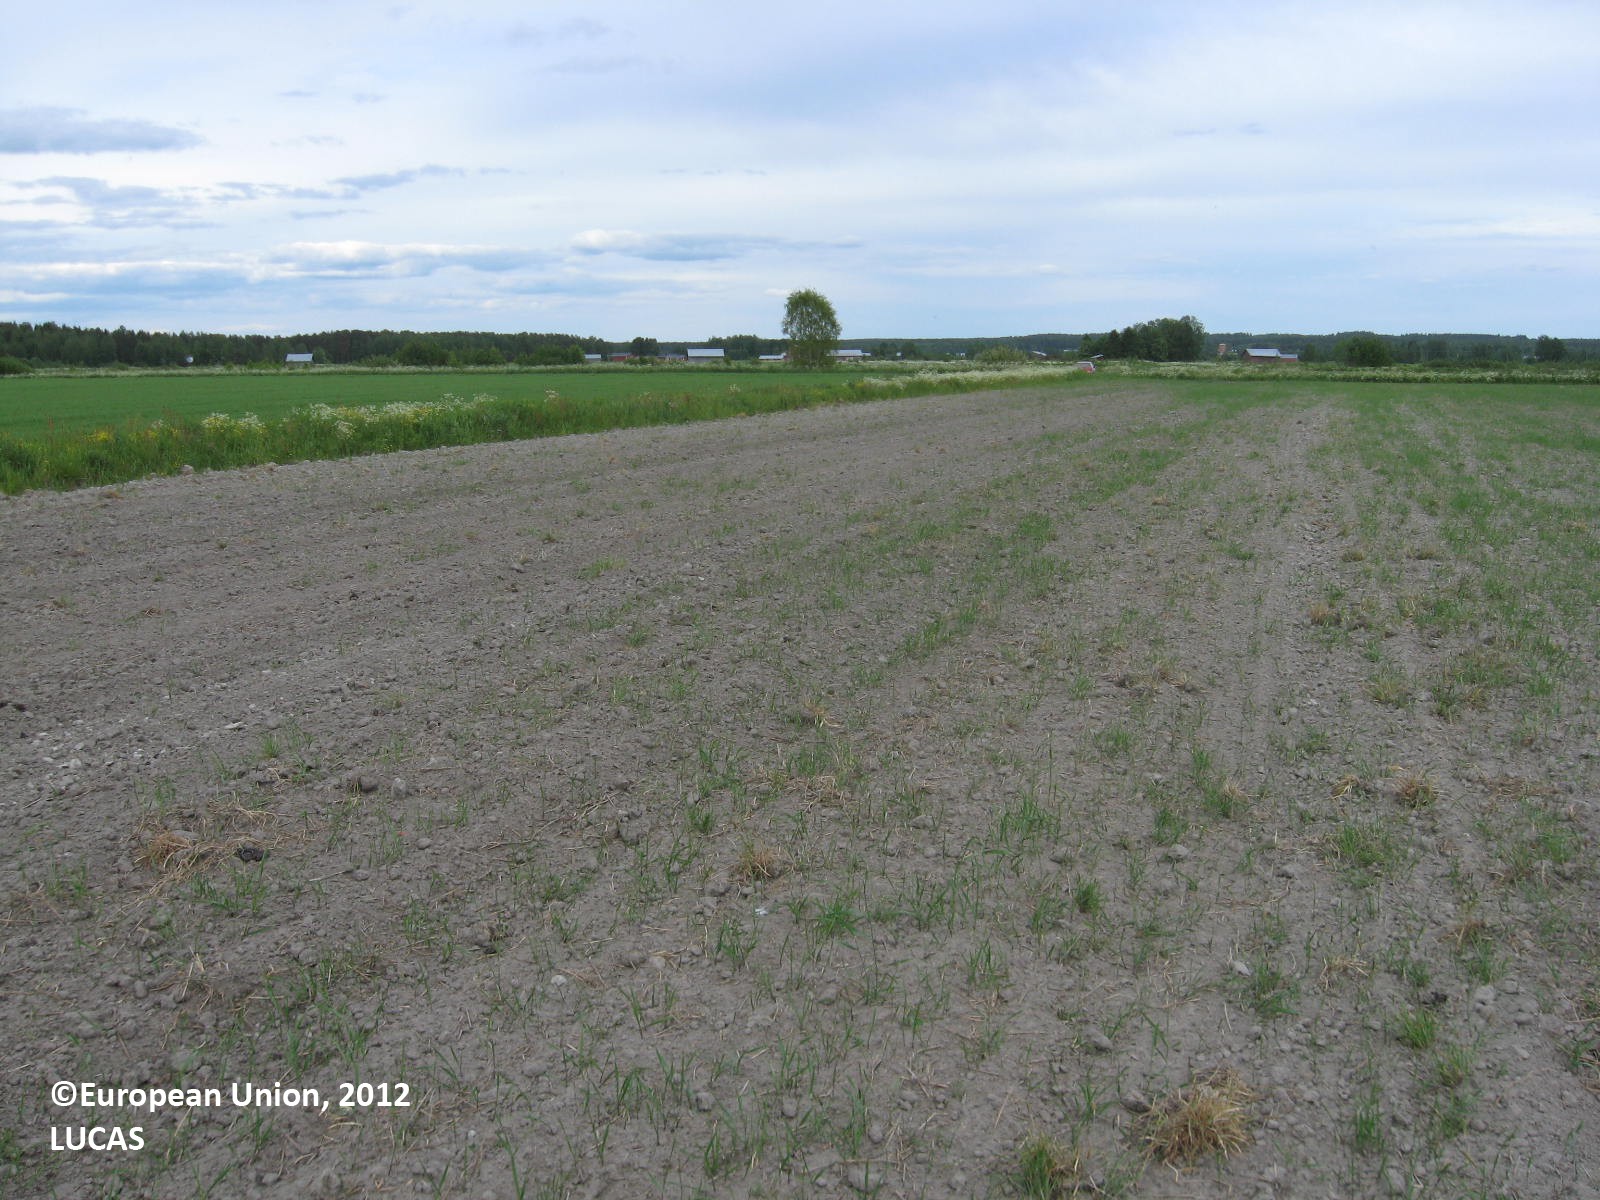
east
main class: Grassland
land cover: Spontaneously vegetated surfaces
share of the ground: 10 - 25 %
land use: Fallow land
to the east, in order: Spontaneously vegetated surfaces; Ditches and canals; Oats; Shruby margins; Ditches and canals; Grass margins; Paved roads, cycling and walking lanes; Grass margins; Ditches and canals; Shruby margins; Oats
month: June
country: FI
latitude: 62.6632
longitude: 21.4999
